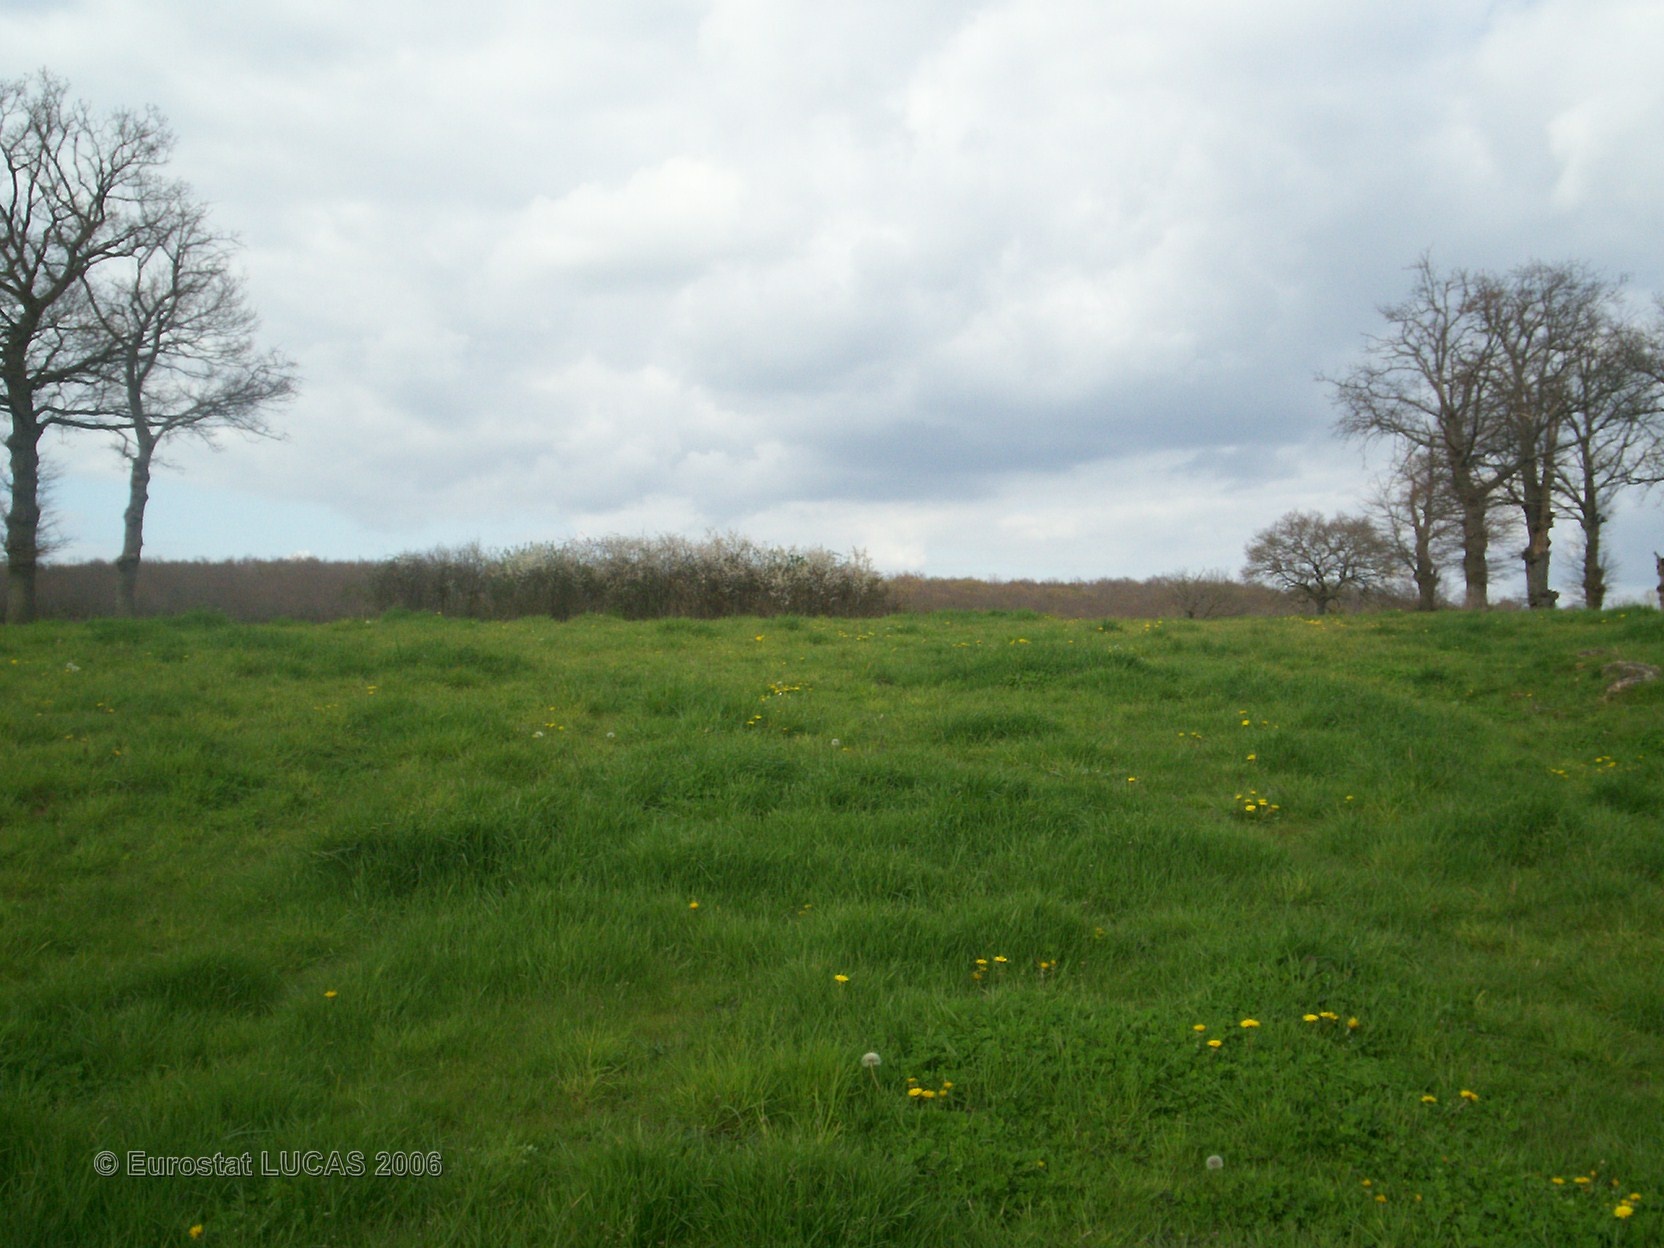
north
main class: Grassland
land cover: Grassland without tree/shrub cover
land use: Agriculture (excluding fallow land and kitchen gardens)
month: April
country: FR
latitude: 46.4302
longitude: 1.0728
